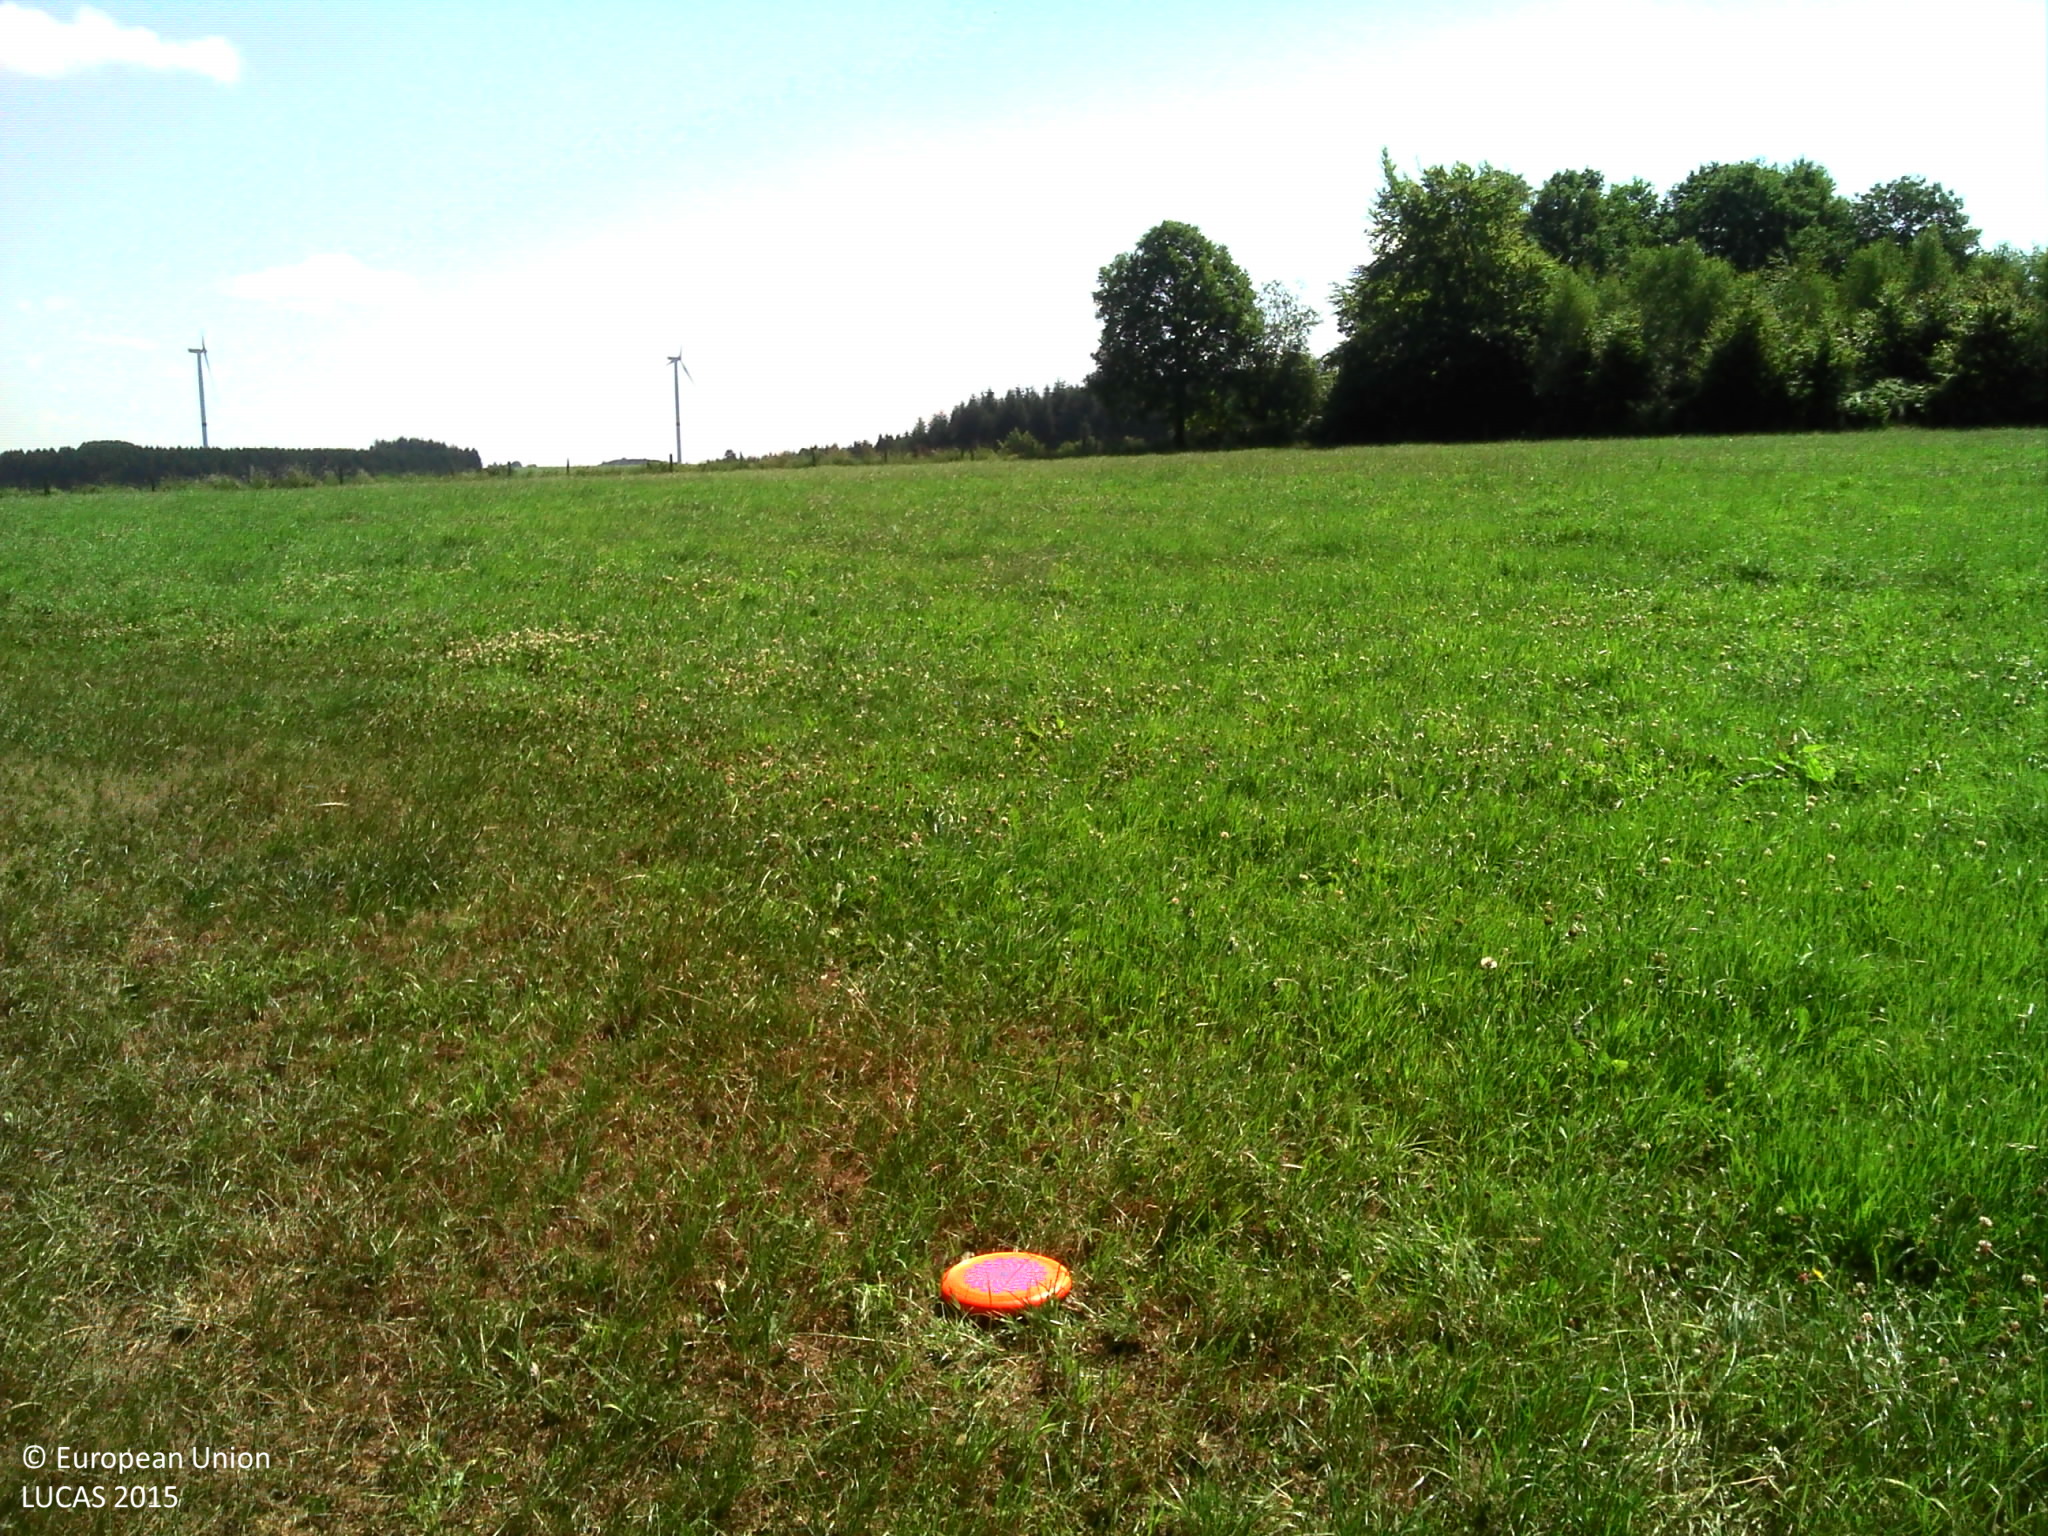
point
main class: Grassland
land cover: Grassland without tree/shrub cover
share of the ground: > 75 %
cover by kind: herbaceous plants 100 %
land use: Agriculture (excluding fallow land and kitchen gardens)
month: July
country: BE
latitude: 50.0517
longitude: 5.7670
